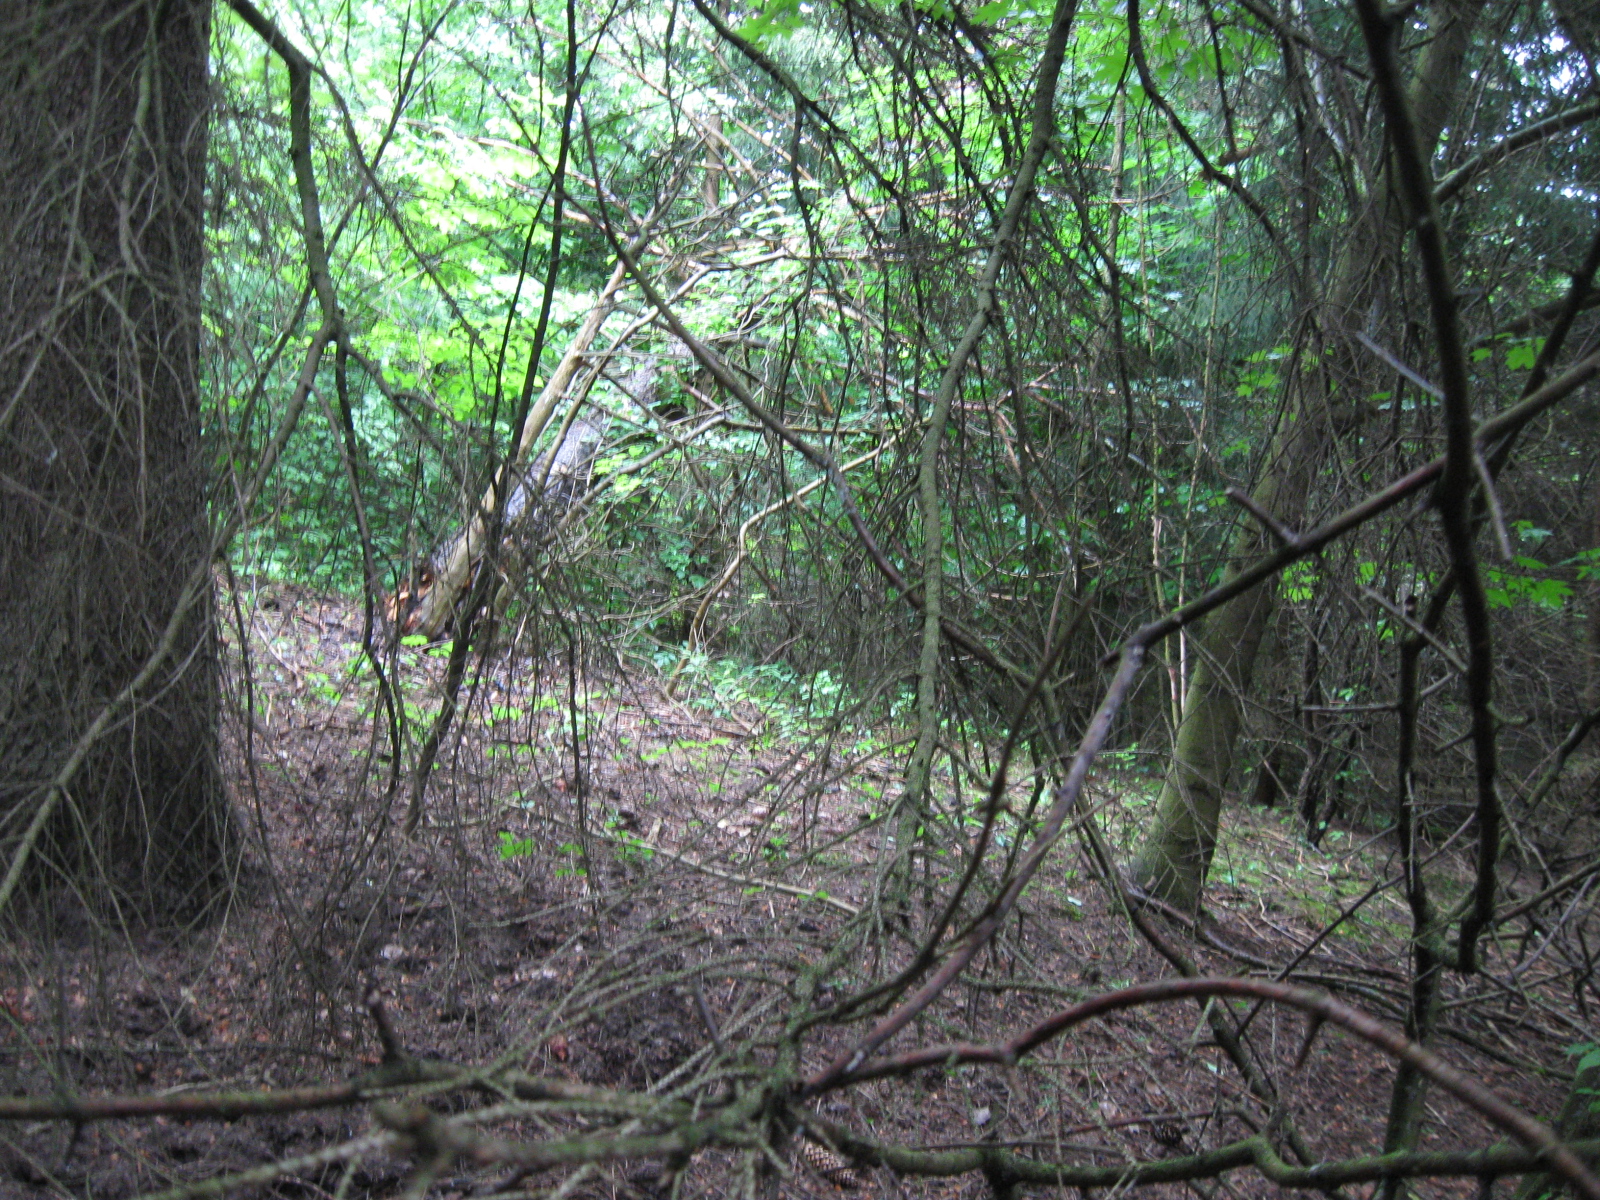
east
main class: Woodland
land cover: Spruce dominated coniferous woodland
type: hemiboreal forest and nemoral coniferous forest and mixed broadleaved-coniferous forest
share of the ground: > 75 %
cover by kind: coniferous forest trees 85 %, broadleaved forest trees 15 %
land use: Forestry
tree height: > 5 m
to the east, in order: Spruce dominated coniferous woodland; Other mixed woodland; Grassland without tree/shrub cover; Broadleaved woodland; Inland fresh running water; Broadleaved woodland; Inland fresh running water; Broadleaved woodland; Electric lines; Broadleaved woodland; Tracks; Broadleaved woodland
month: June
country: LT
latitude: 54.6025
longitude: 24.3885
